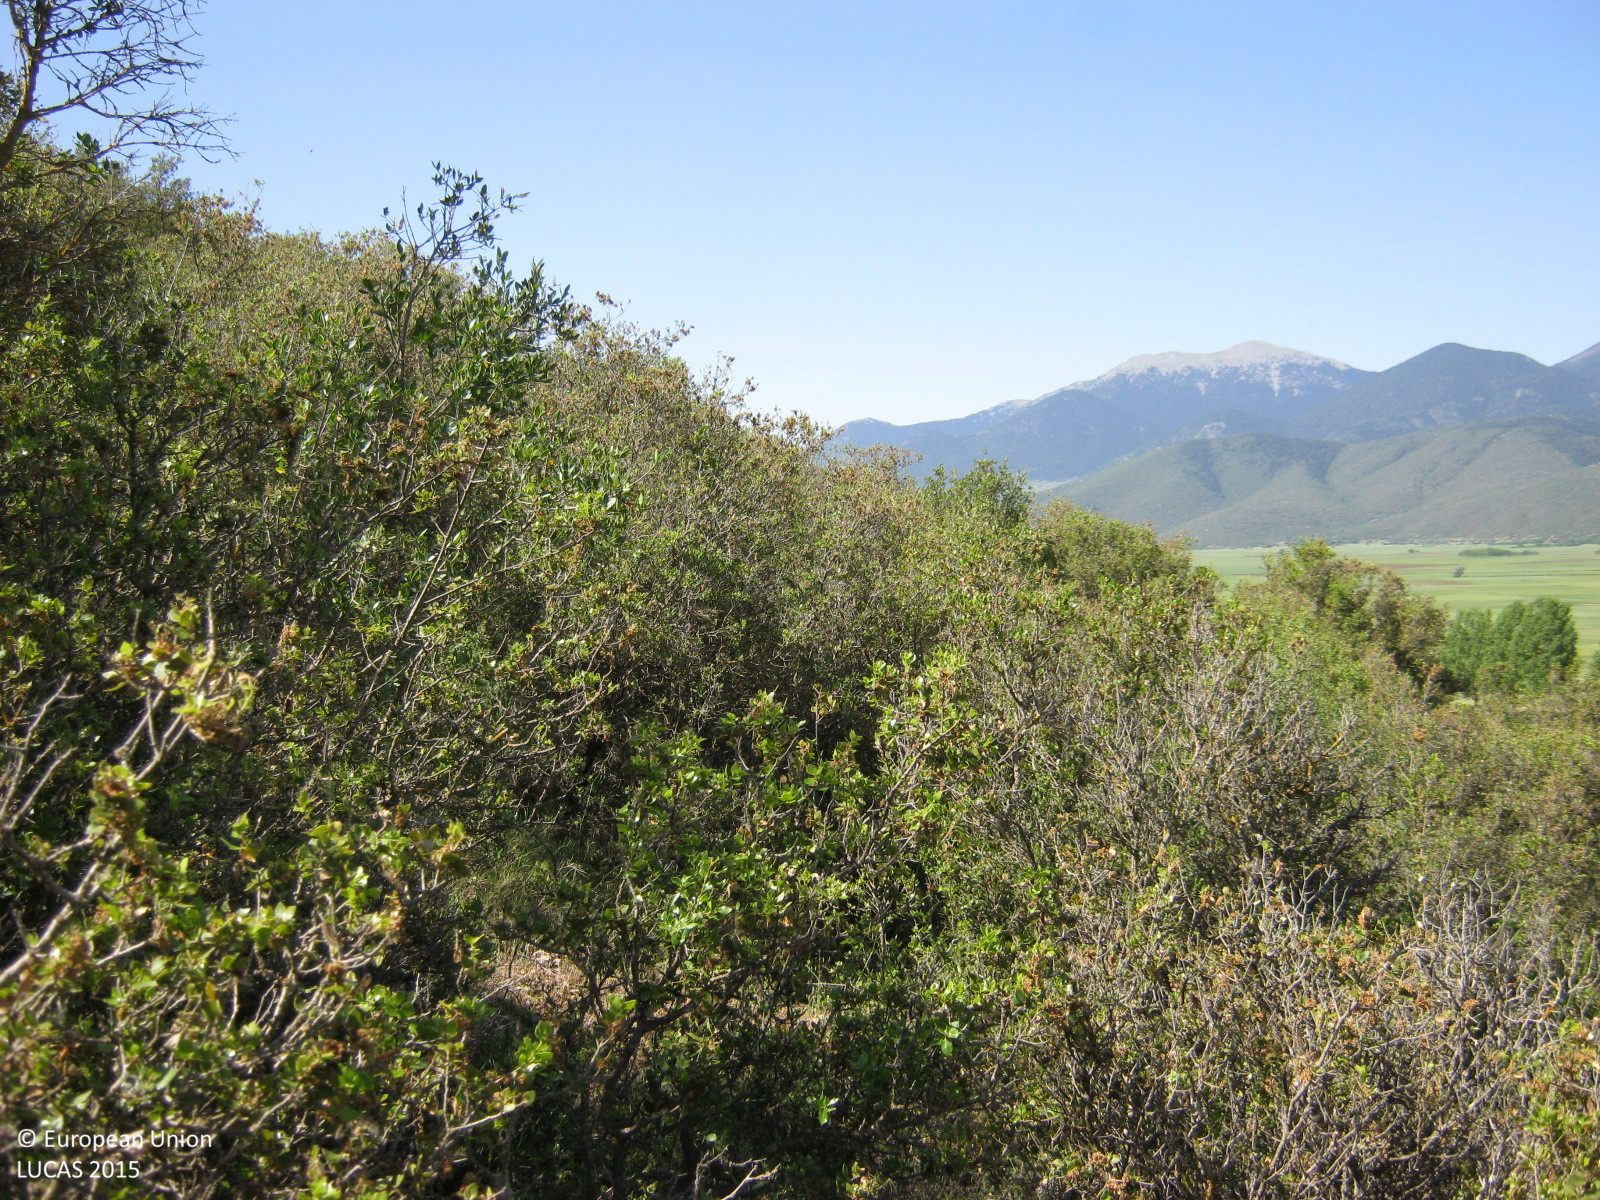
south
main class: Shrubland
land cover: Shrubland with sparse tree cover
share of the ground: 50 - 75 %
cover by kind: shrubs 70 %, herbaceous plants 25 %, coniferous forest trees 5 %
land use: Forestry
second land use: Agriculture (excluding fallow land and kitchen gardens)
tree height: > 5 m
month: May
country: GR
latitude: 37.6684
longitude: 22.3781
